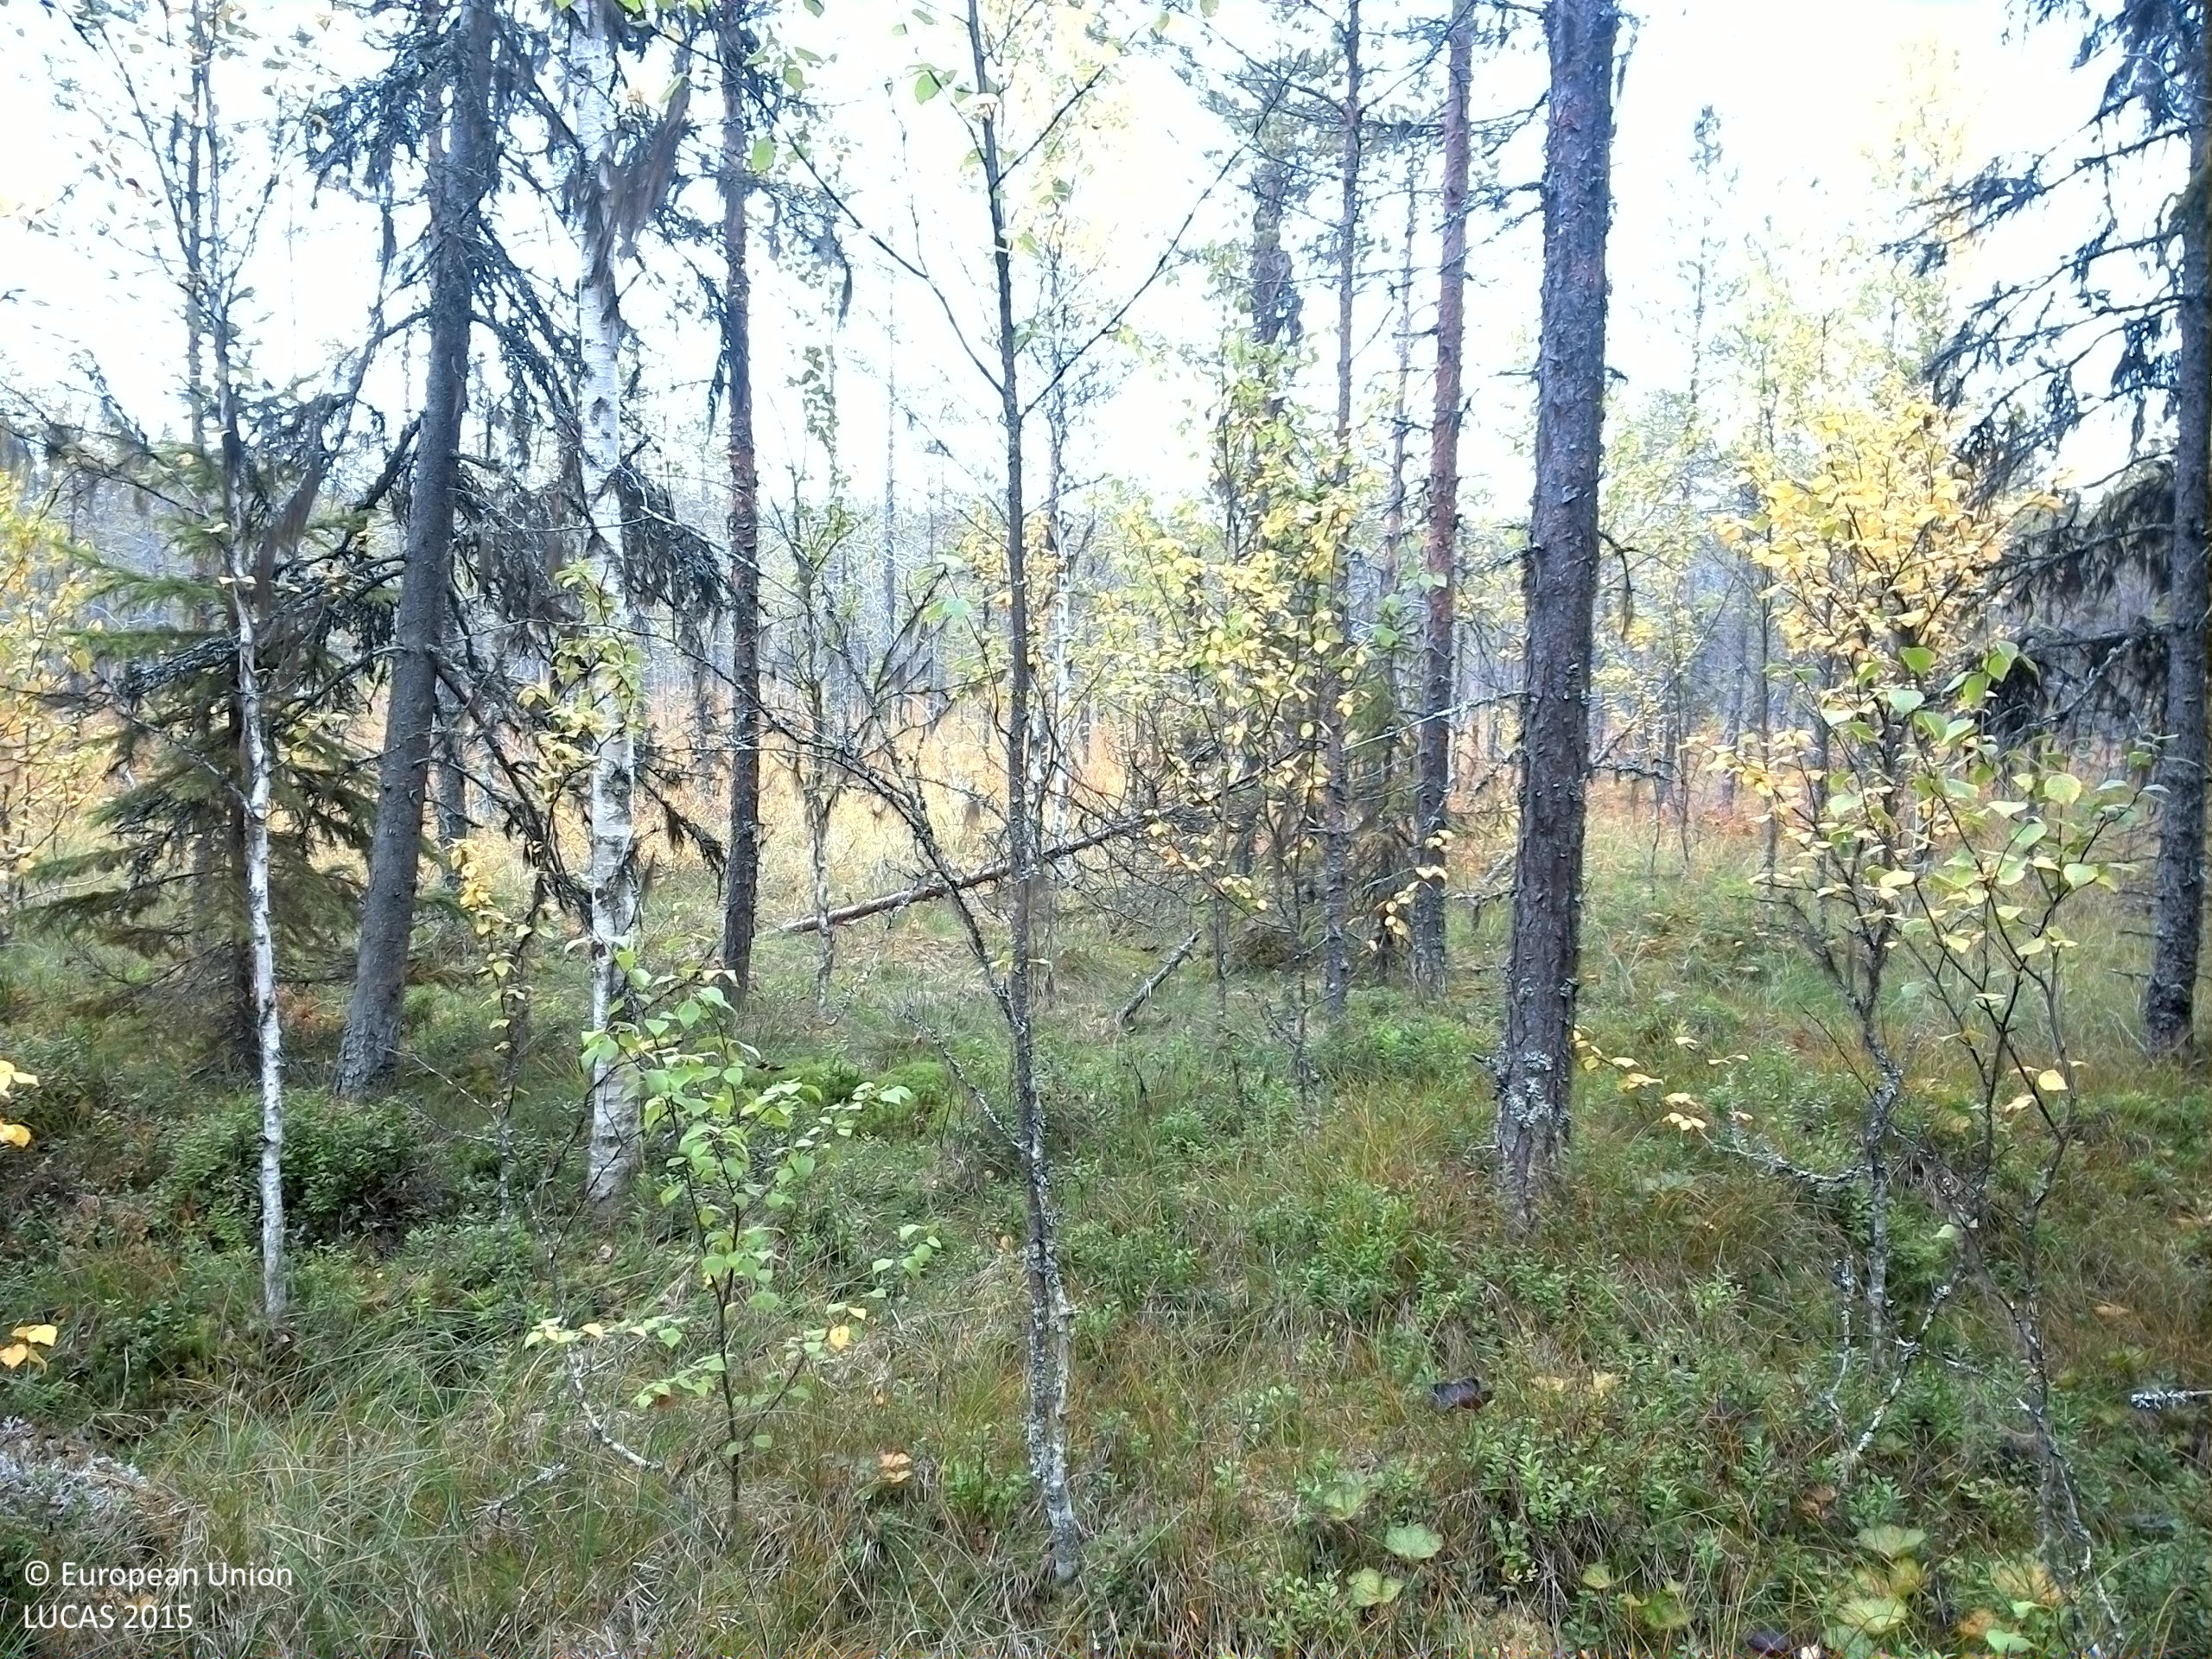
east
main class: Woodland
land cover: Spruce dominated coniferous woodland
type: boreal forest
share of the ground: 50 - 75 %
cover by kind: coniferous forest trees 55 %, shrubs 20 %, broadleaved forest trees 15 %, lichens and mosses 10 %
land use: Forestry
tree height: > 5 m
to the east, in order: Spruce dominated coniferous woodland; Pine dominated coniferous woodland; Peatbogs; Other coniferous woodland; Pine dominated coniferous woodland
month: September
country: SE
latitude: 63.8874
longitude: 16.4270
